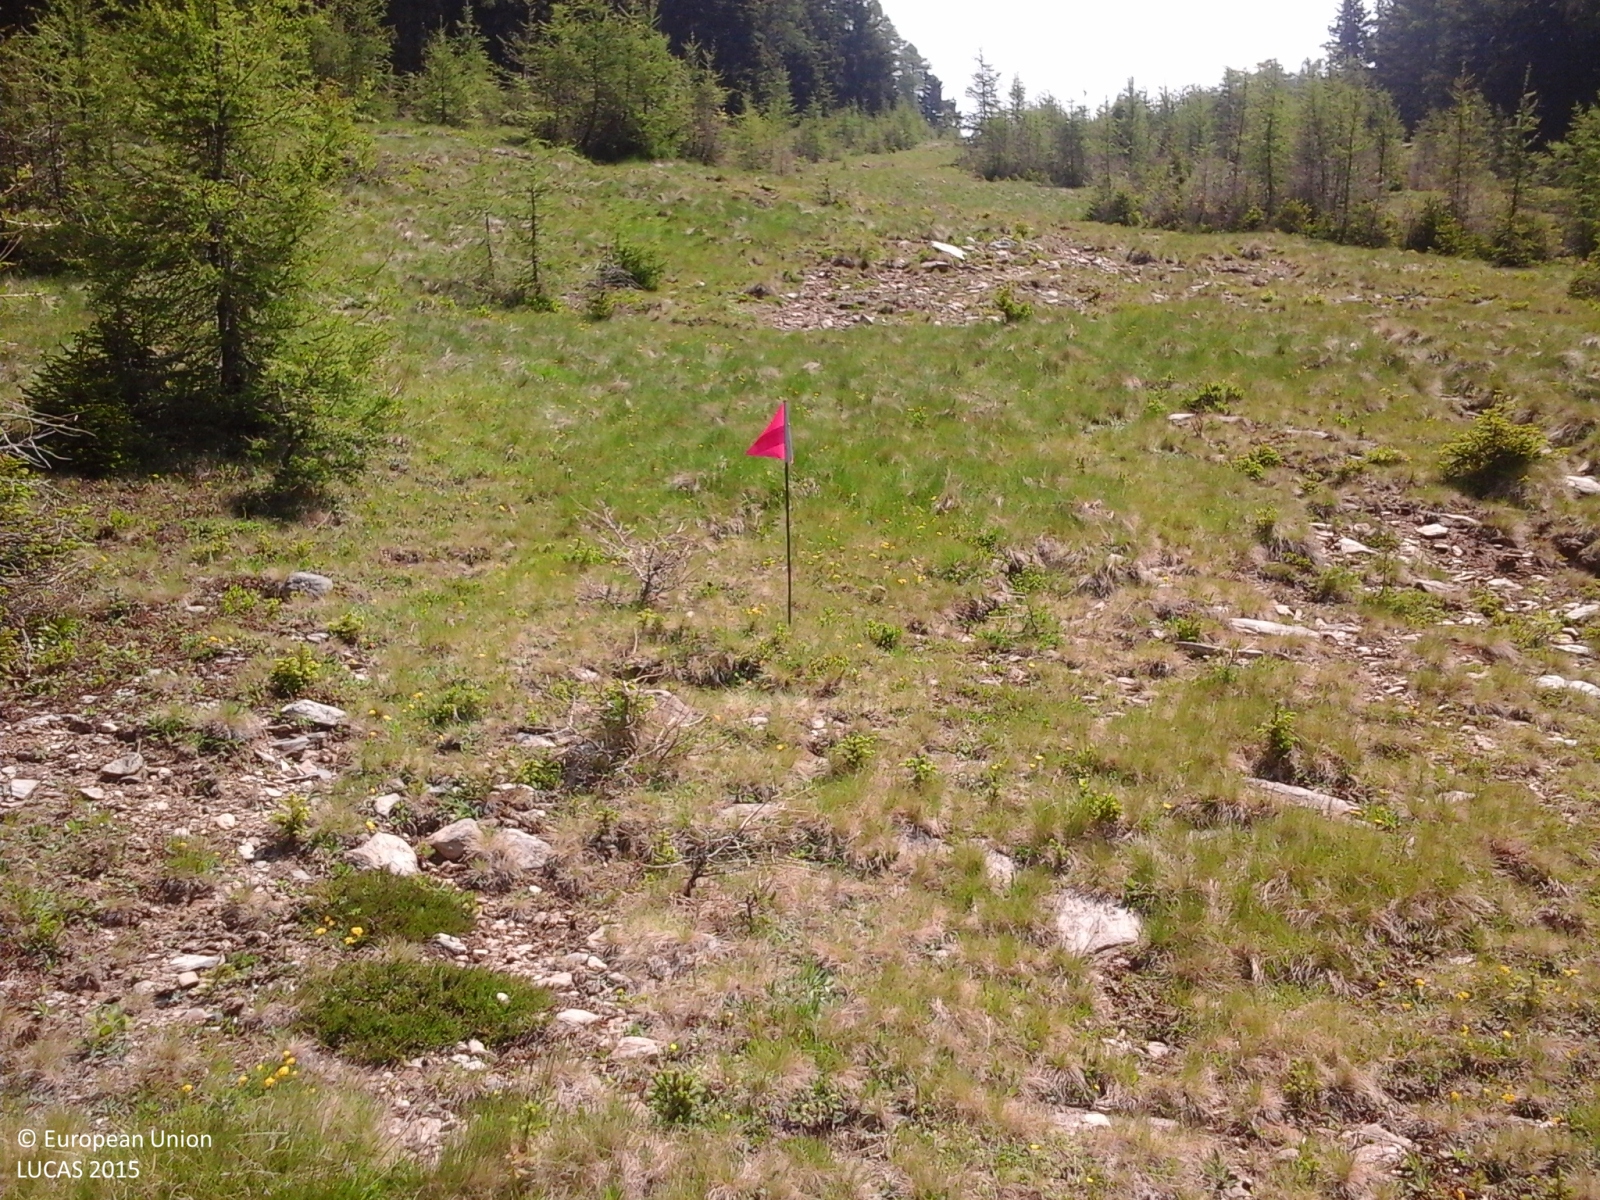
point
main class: Grassland
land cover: Grassland with sparse tree/shrub cover
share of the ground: > 75 %
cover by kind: herbaceous plants 95 %, coniferous forest trees 5 %
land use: Agriculture (excluding fallow land and kitchen gardens)
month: June
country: IT
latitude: 46.7403
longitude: 11.2419
